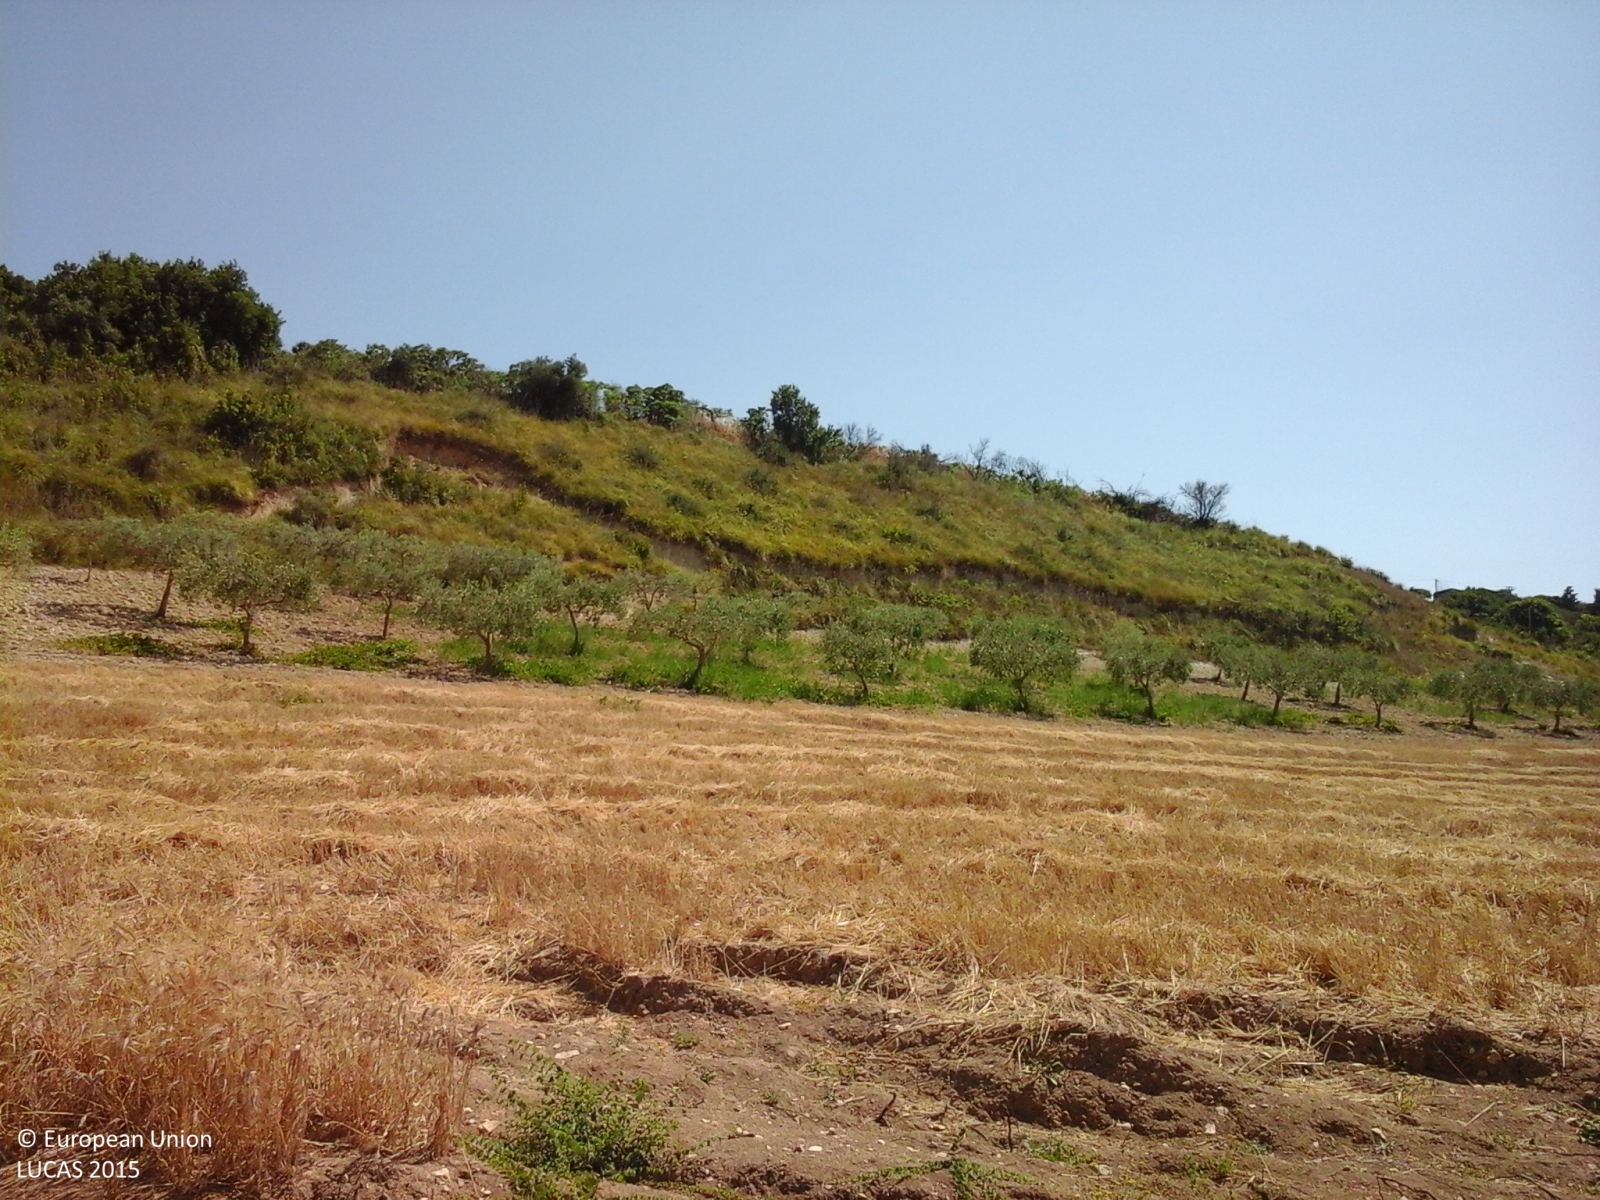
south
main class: Woodland
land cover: Other mixed woodland
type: coniferous forest of the mediterranean region
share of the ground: > 75 %
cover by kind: coniferous forest trees 35 %, broadleaved forest trees 35 %, shrubs 20 %, herbaceous plants 10 %
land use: Forestry
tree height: > 5 m
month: June
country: IT
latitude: 37.6420
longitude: 13.1158
